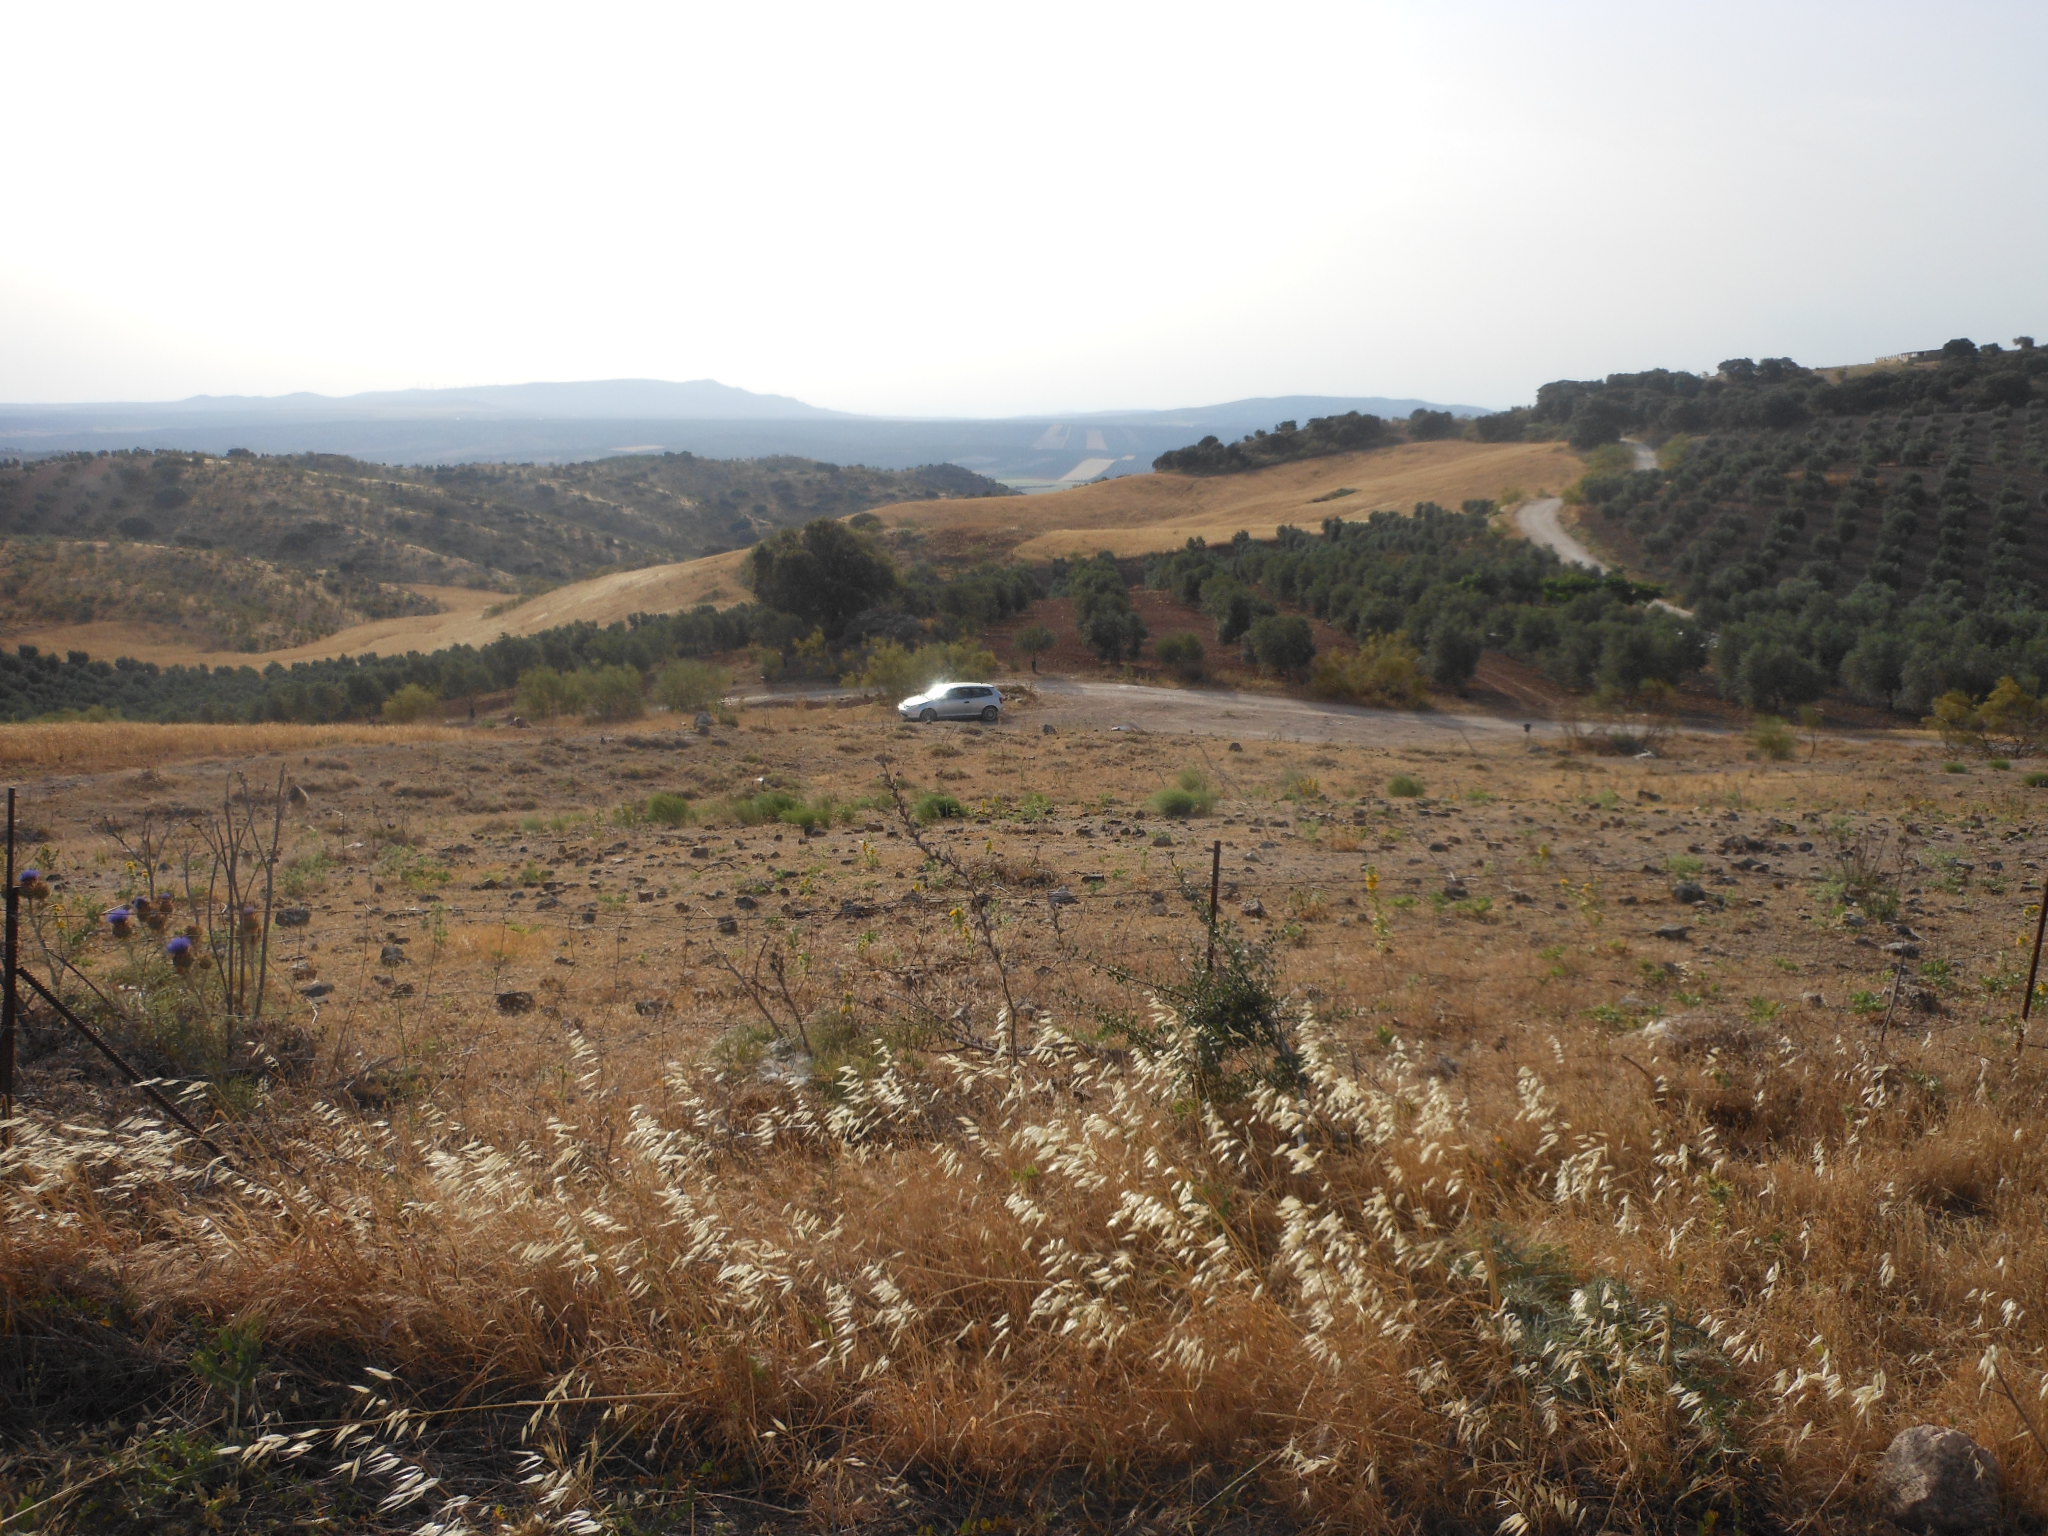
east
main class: Cropland
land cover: Olive groves
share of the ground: 10 - 25 %
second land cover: Spontaneously vegetated surfaces
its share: 50 - 75 %
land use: Agriculture (excluding fallow land and kitchen gardens)
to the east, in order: Olive groves; Spontaneously vegetated surfaces; Grass margins; Fences; Grassland without tree/shrub cover; Tracks; Shrubland without tree cover; Tracks; Fences; Shrubland without tree cover; Rock outcrops; Olive groves
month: June
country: ES
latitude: 37.1342
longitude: -5.0326
